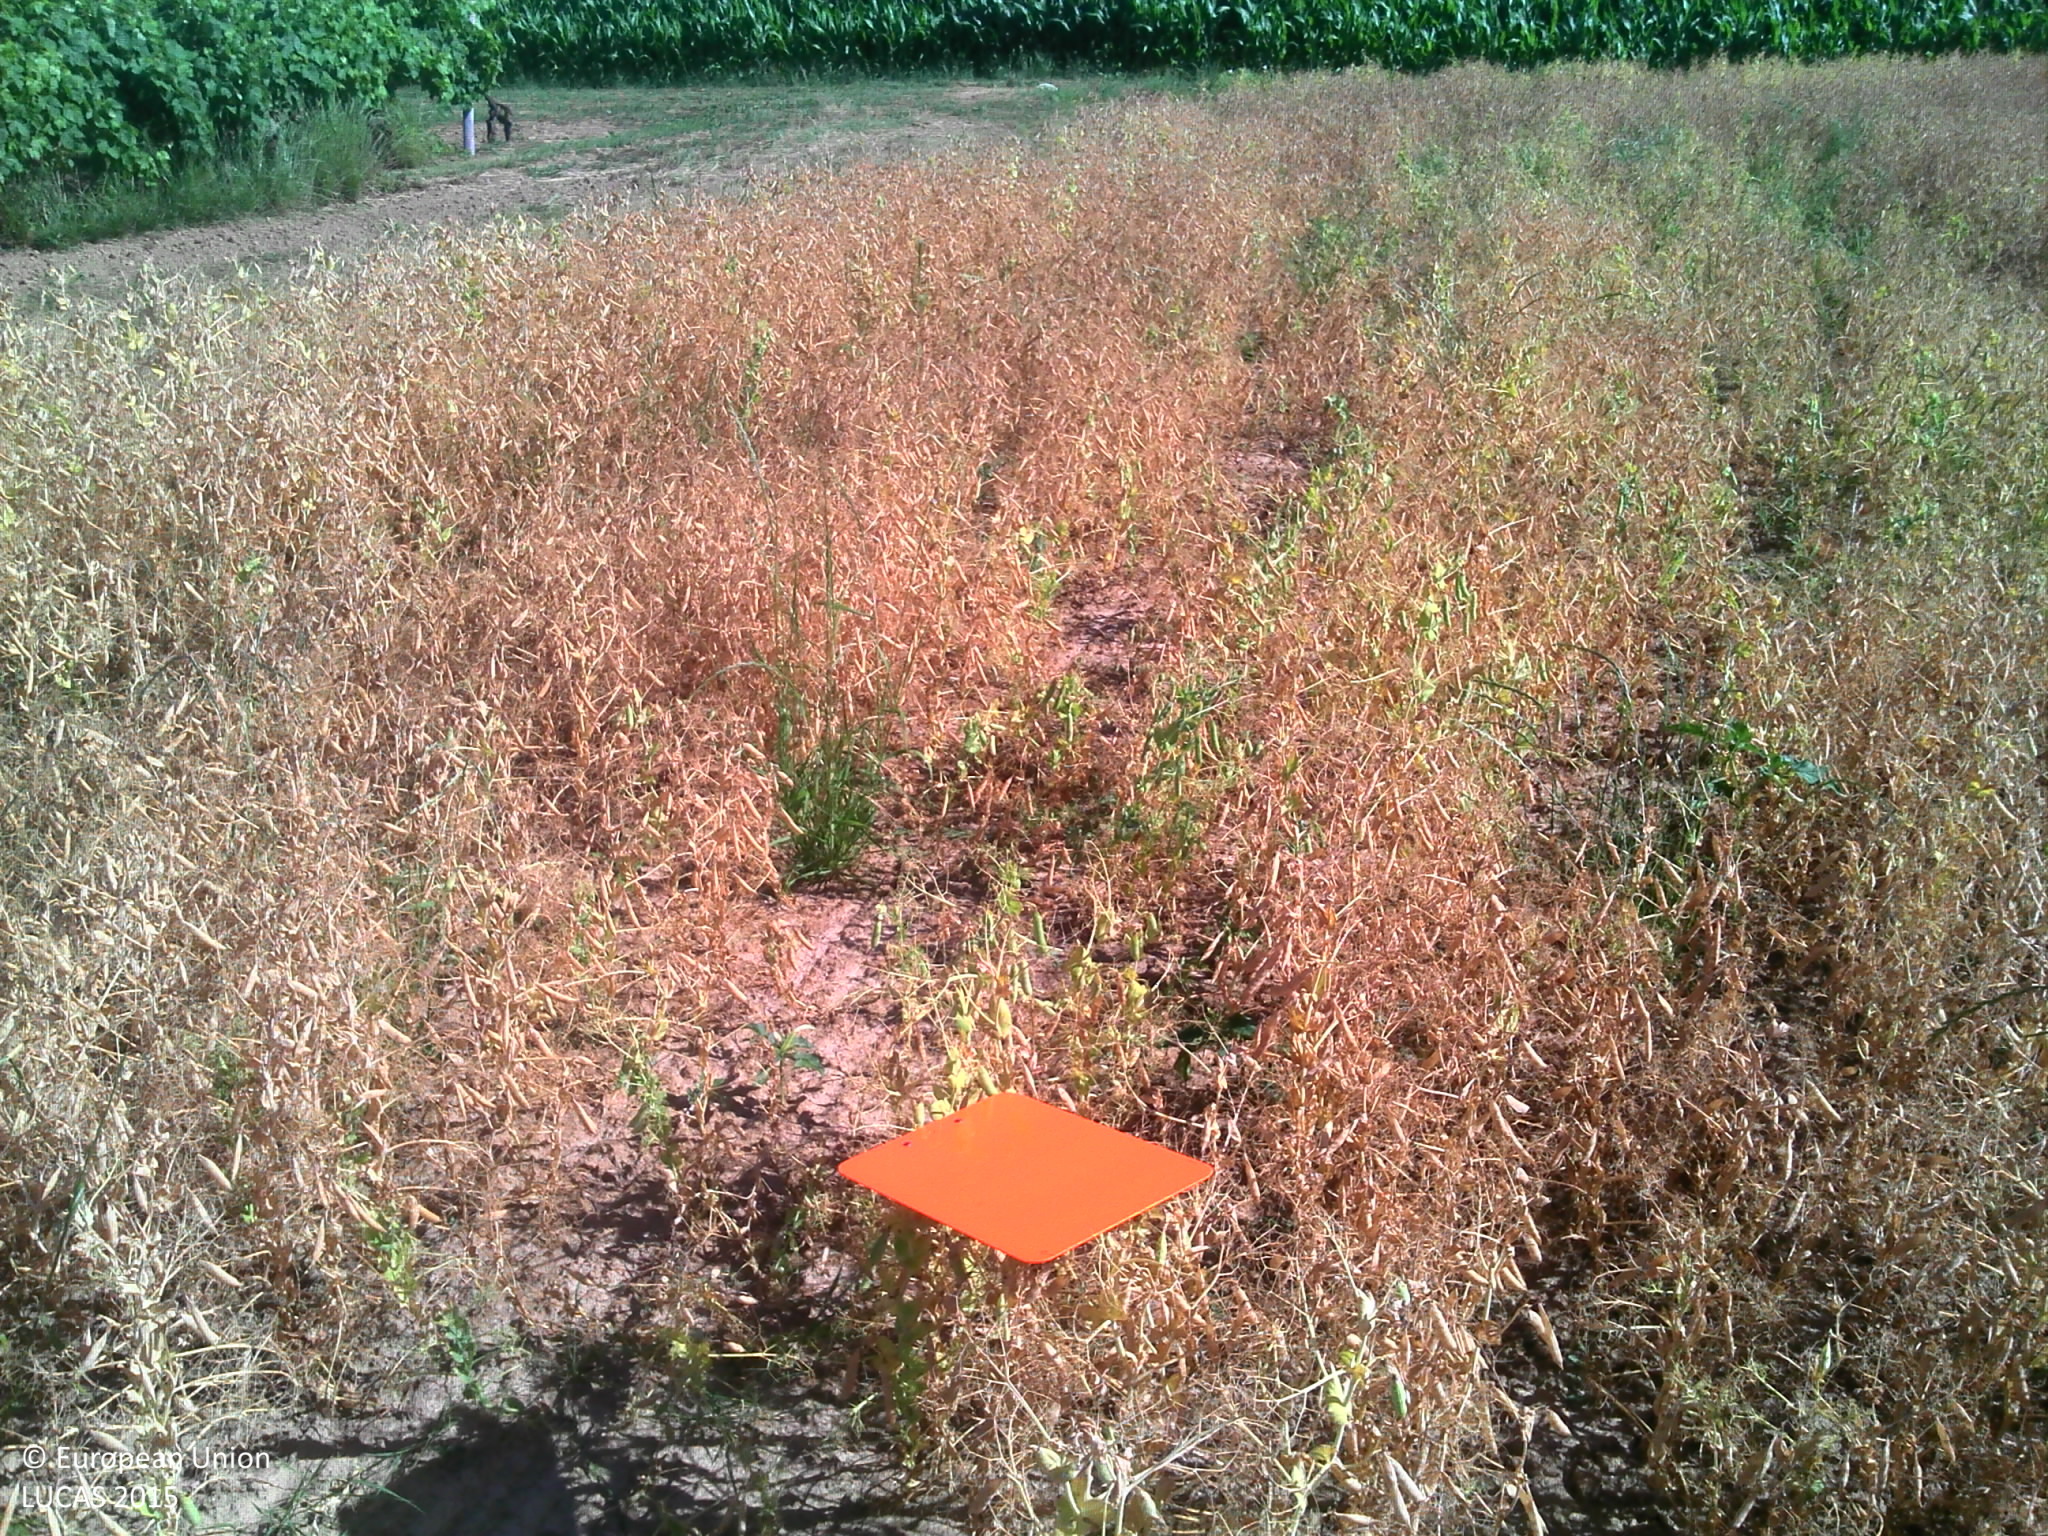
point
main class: Cropland
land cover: Dry pulses
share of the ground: > 75 %
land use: Agriculture (excluding fallow land and kitchen gardens)
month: June
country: FR
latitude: 45.6303
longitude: -0.7094
